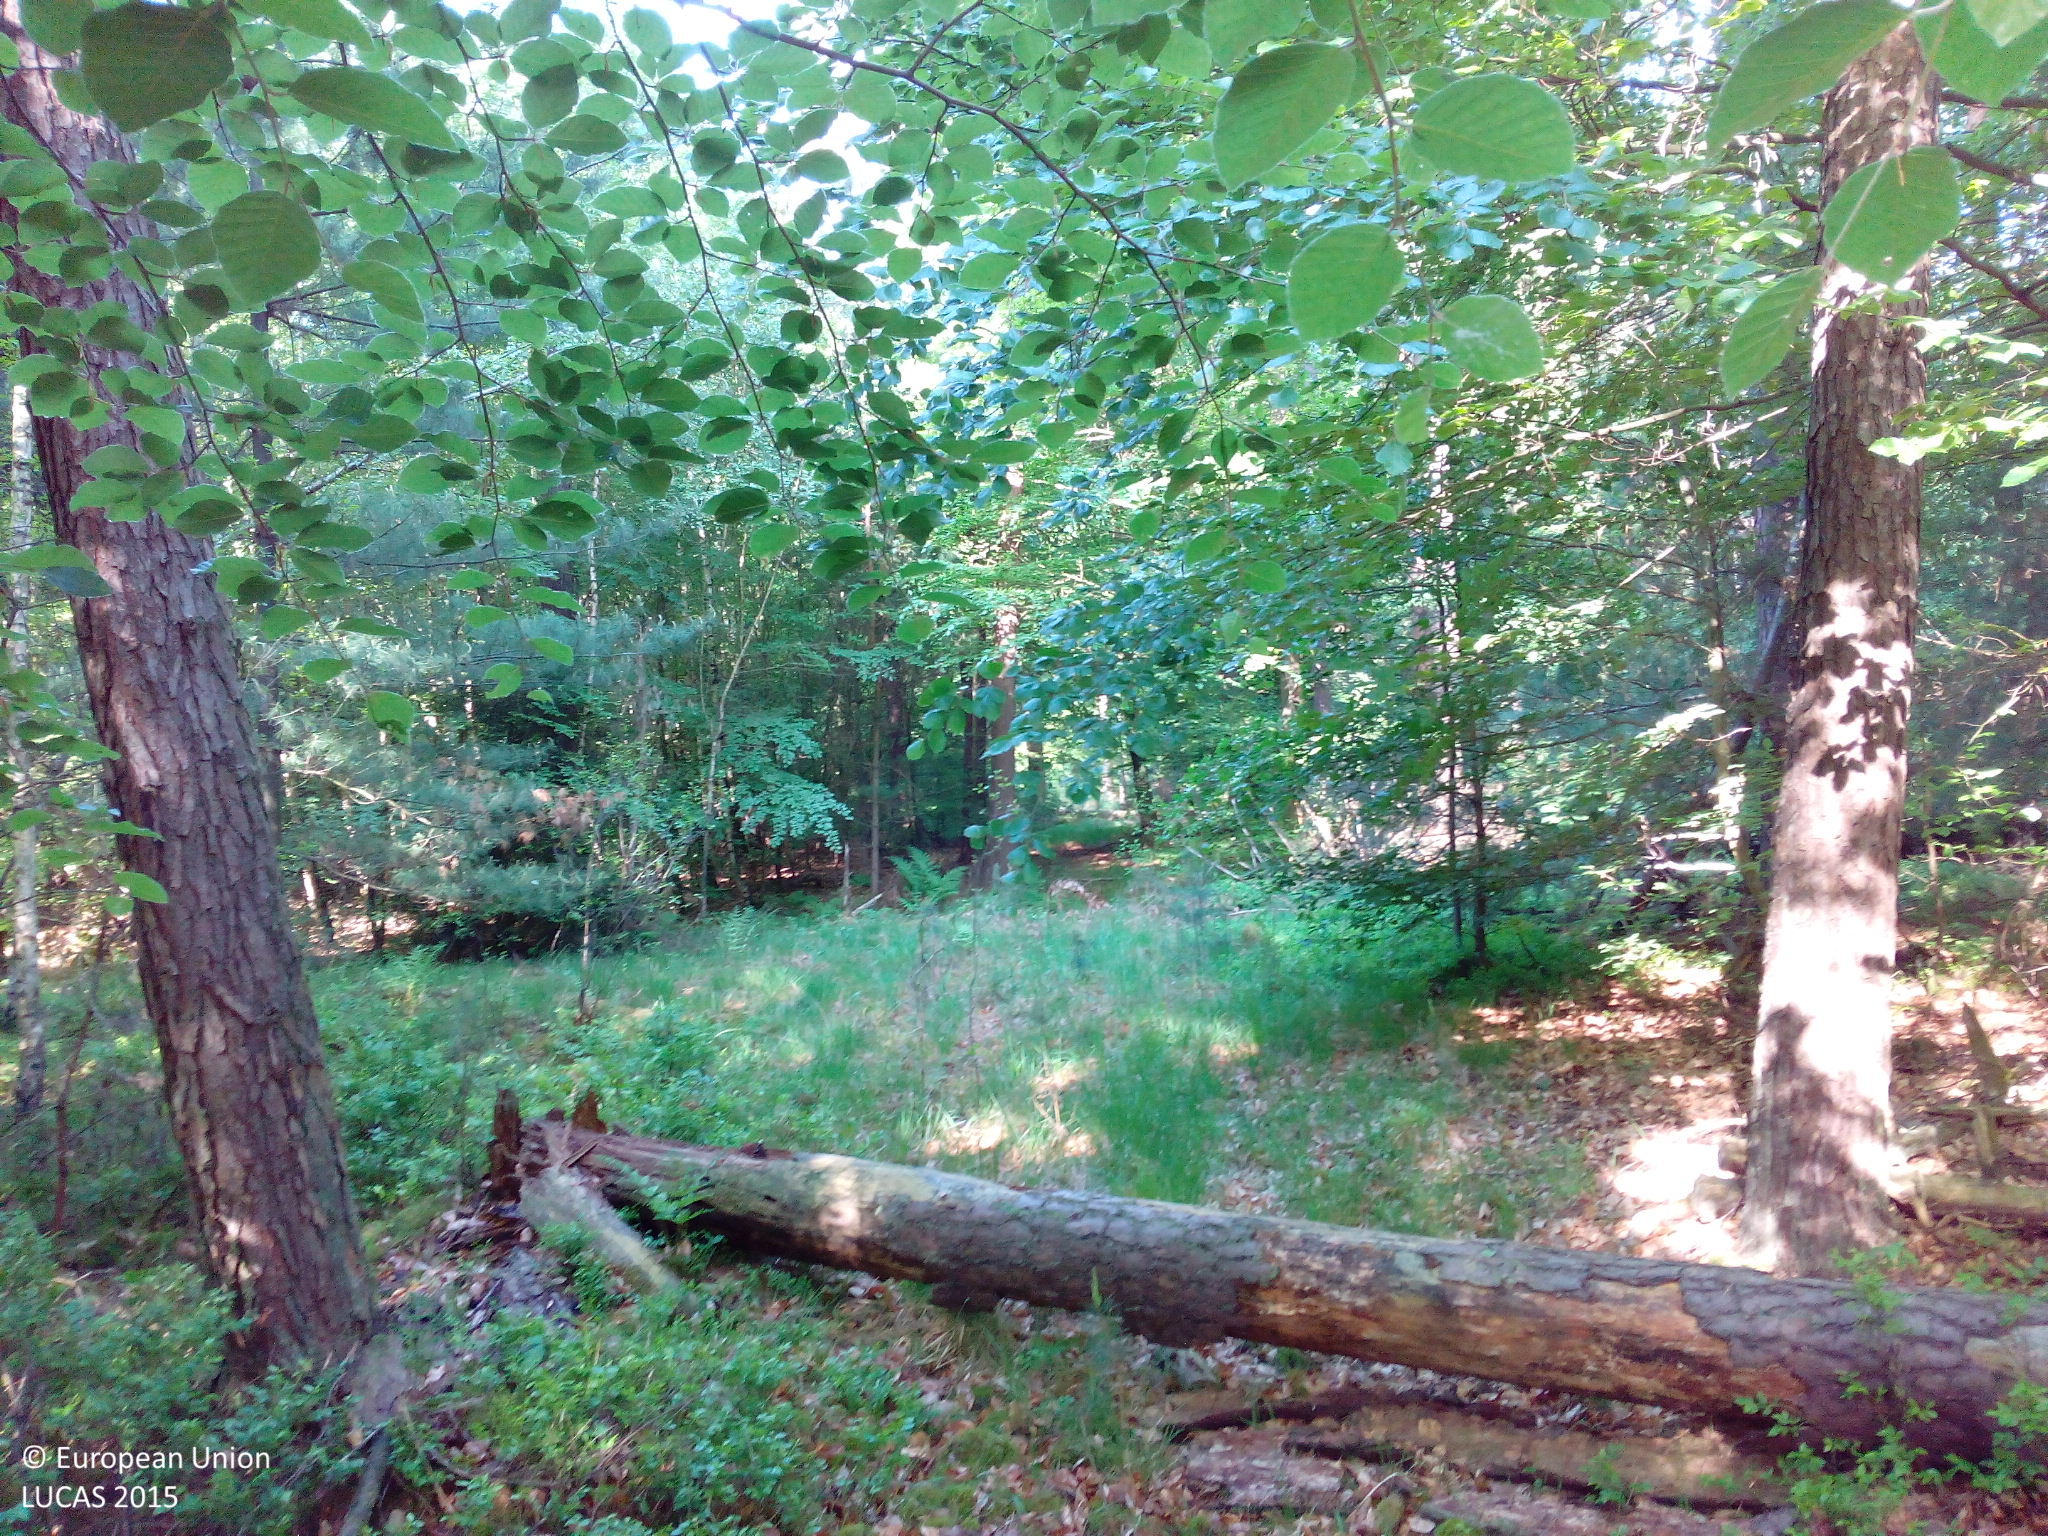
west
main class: Woodland
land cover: Other mixed woodland
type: hemiboreal forest and nemoral coniferous forest and mixed broadleaved-coniferous forest
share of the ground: > 75 %
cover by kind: broadleaved forest trees 60 %, coniferous forest trees 20 %, shrubs 10 %, herbaceous plants 5 %, unconsolidated bare surface 5 %
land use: Forestry
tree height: > 5 m
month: May
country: DE
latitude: 49.0544
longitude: 8.1807
